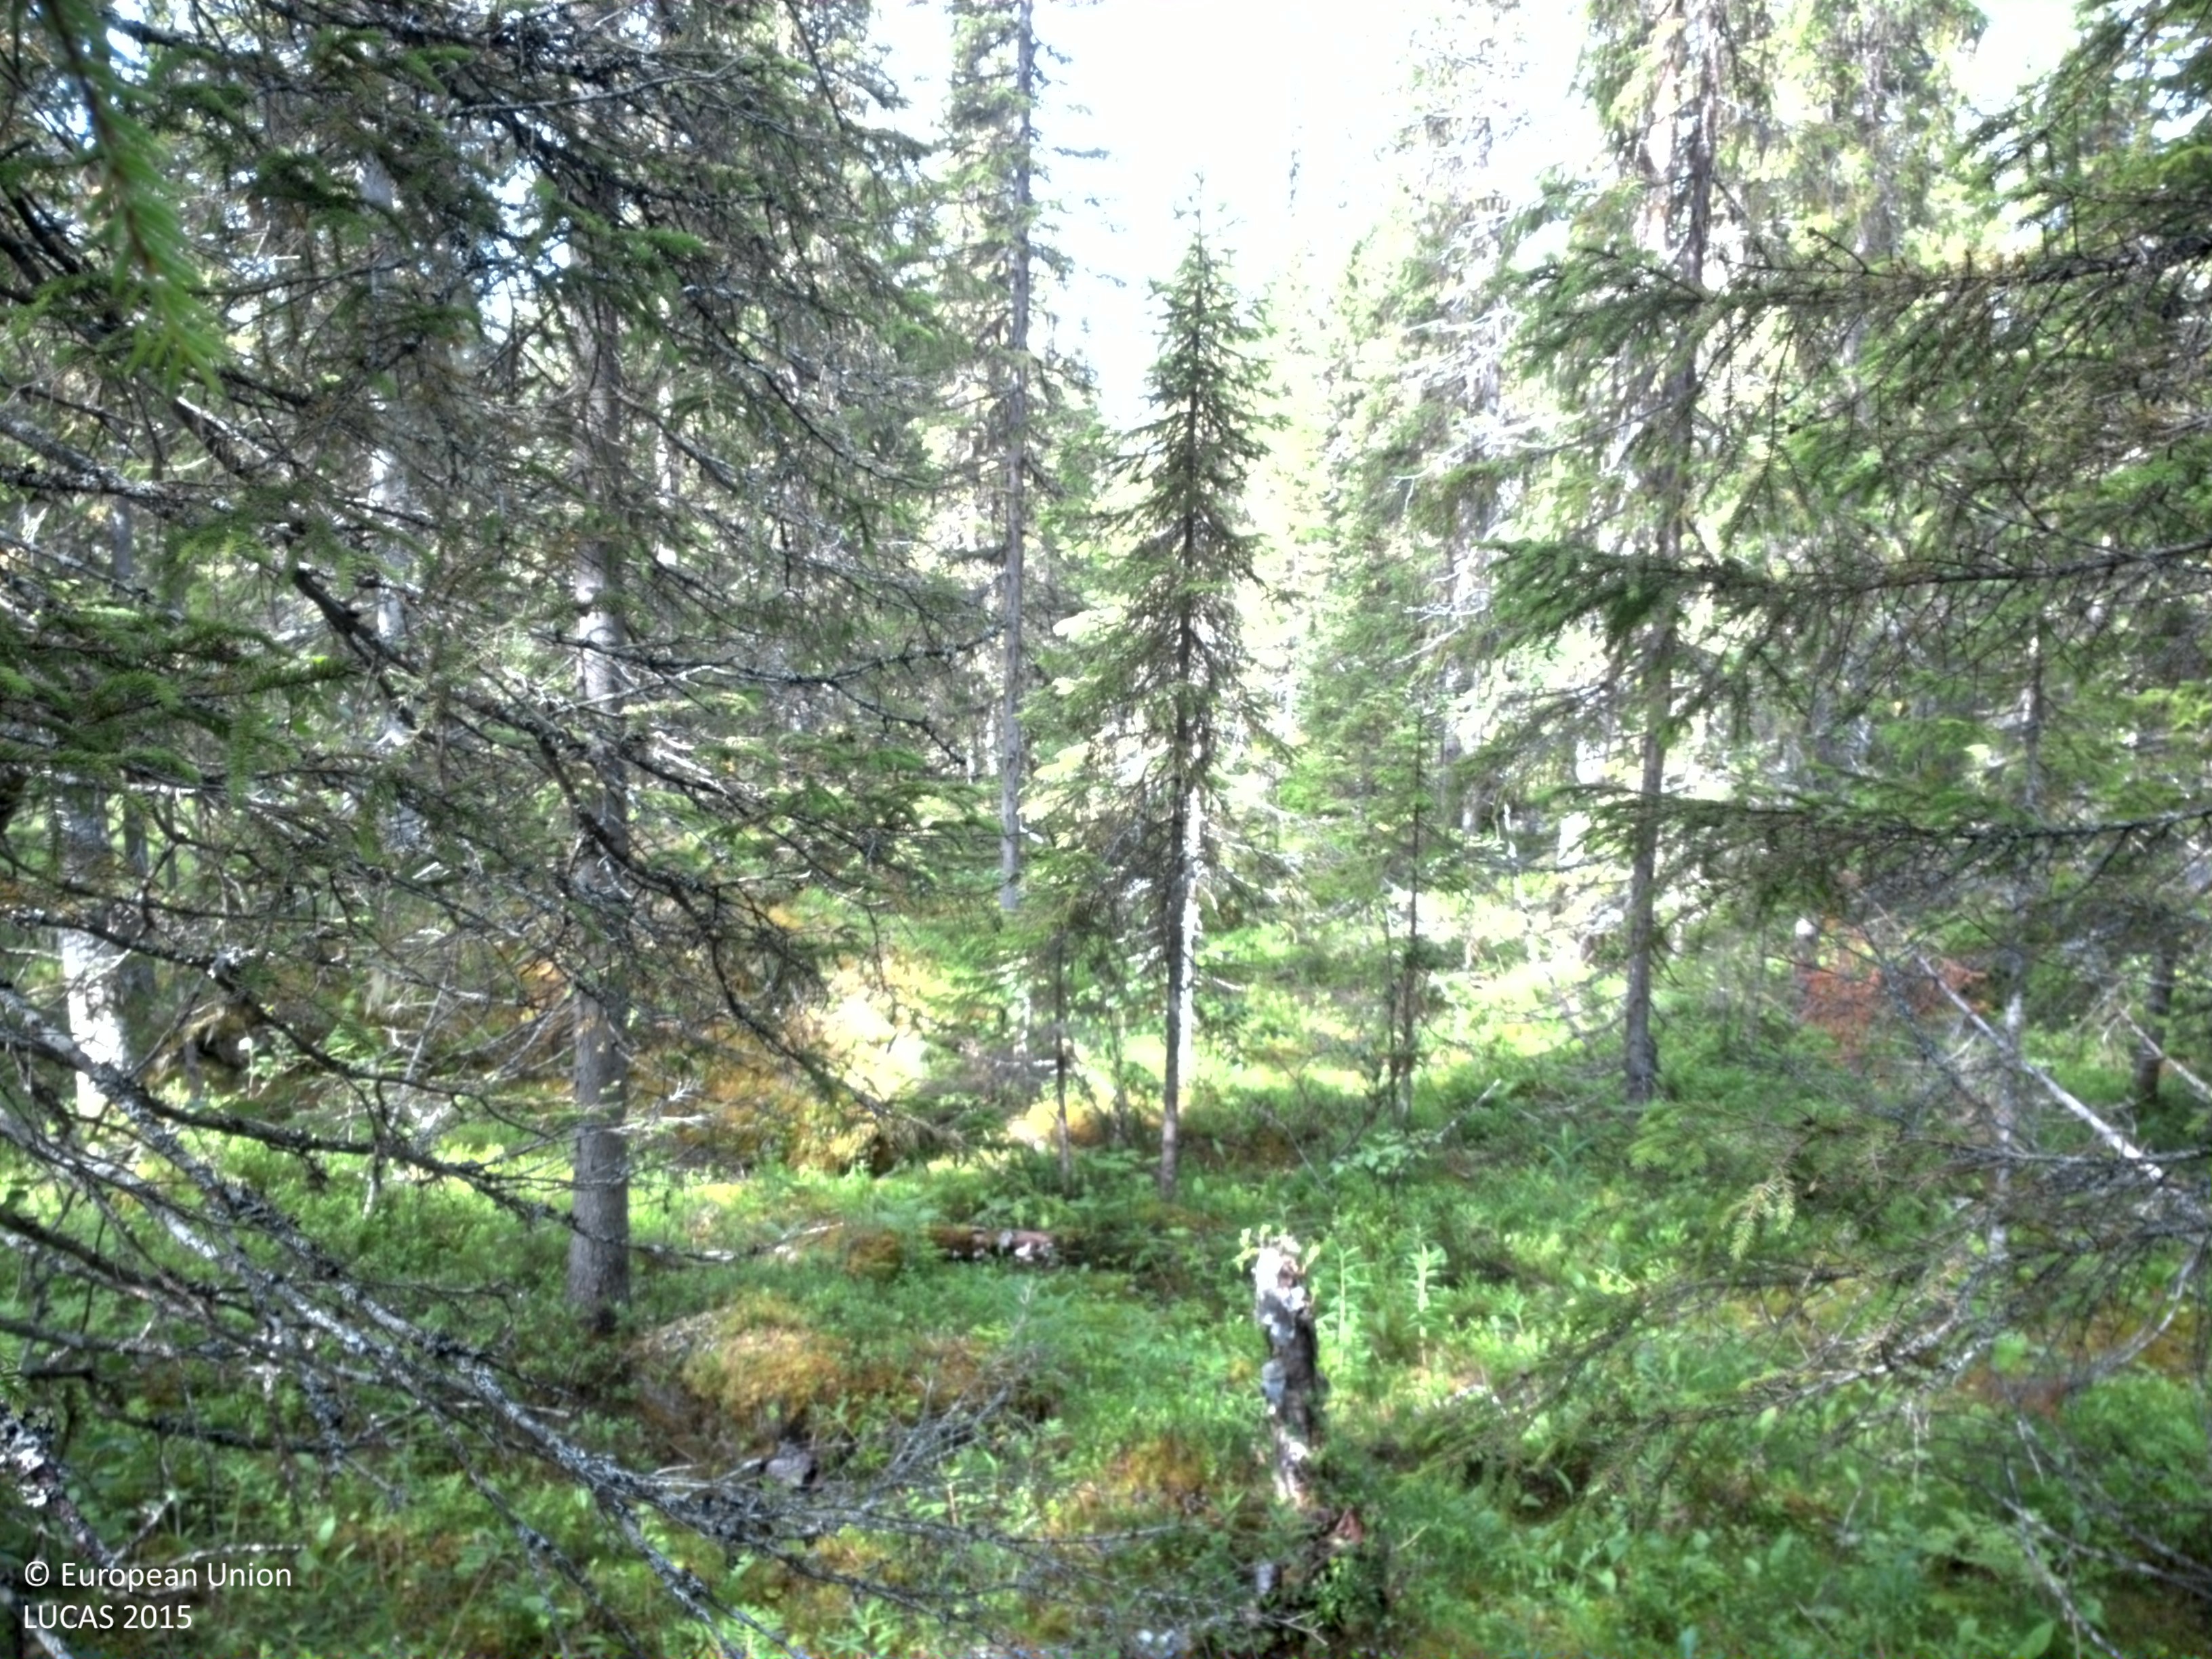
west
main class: Woodland
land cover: Spruce dominated coniferous woodland
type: boreal forest
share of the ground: 50 - 75 %
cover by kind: coniferous forest trees 50 %, shrubs 35 %, lichens and mosses 10 %, herbaceous plants 5 %
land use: Forestry
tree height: > 5 m
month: August
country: SE
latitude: 64.9386
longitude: 15.9541
